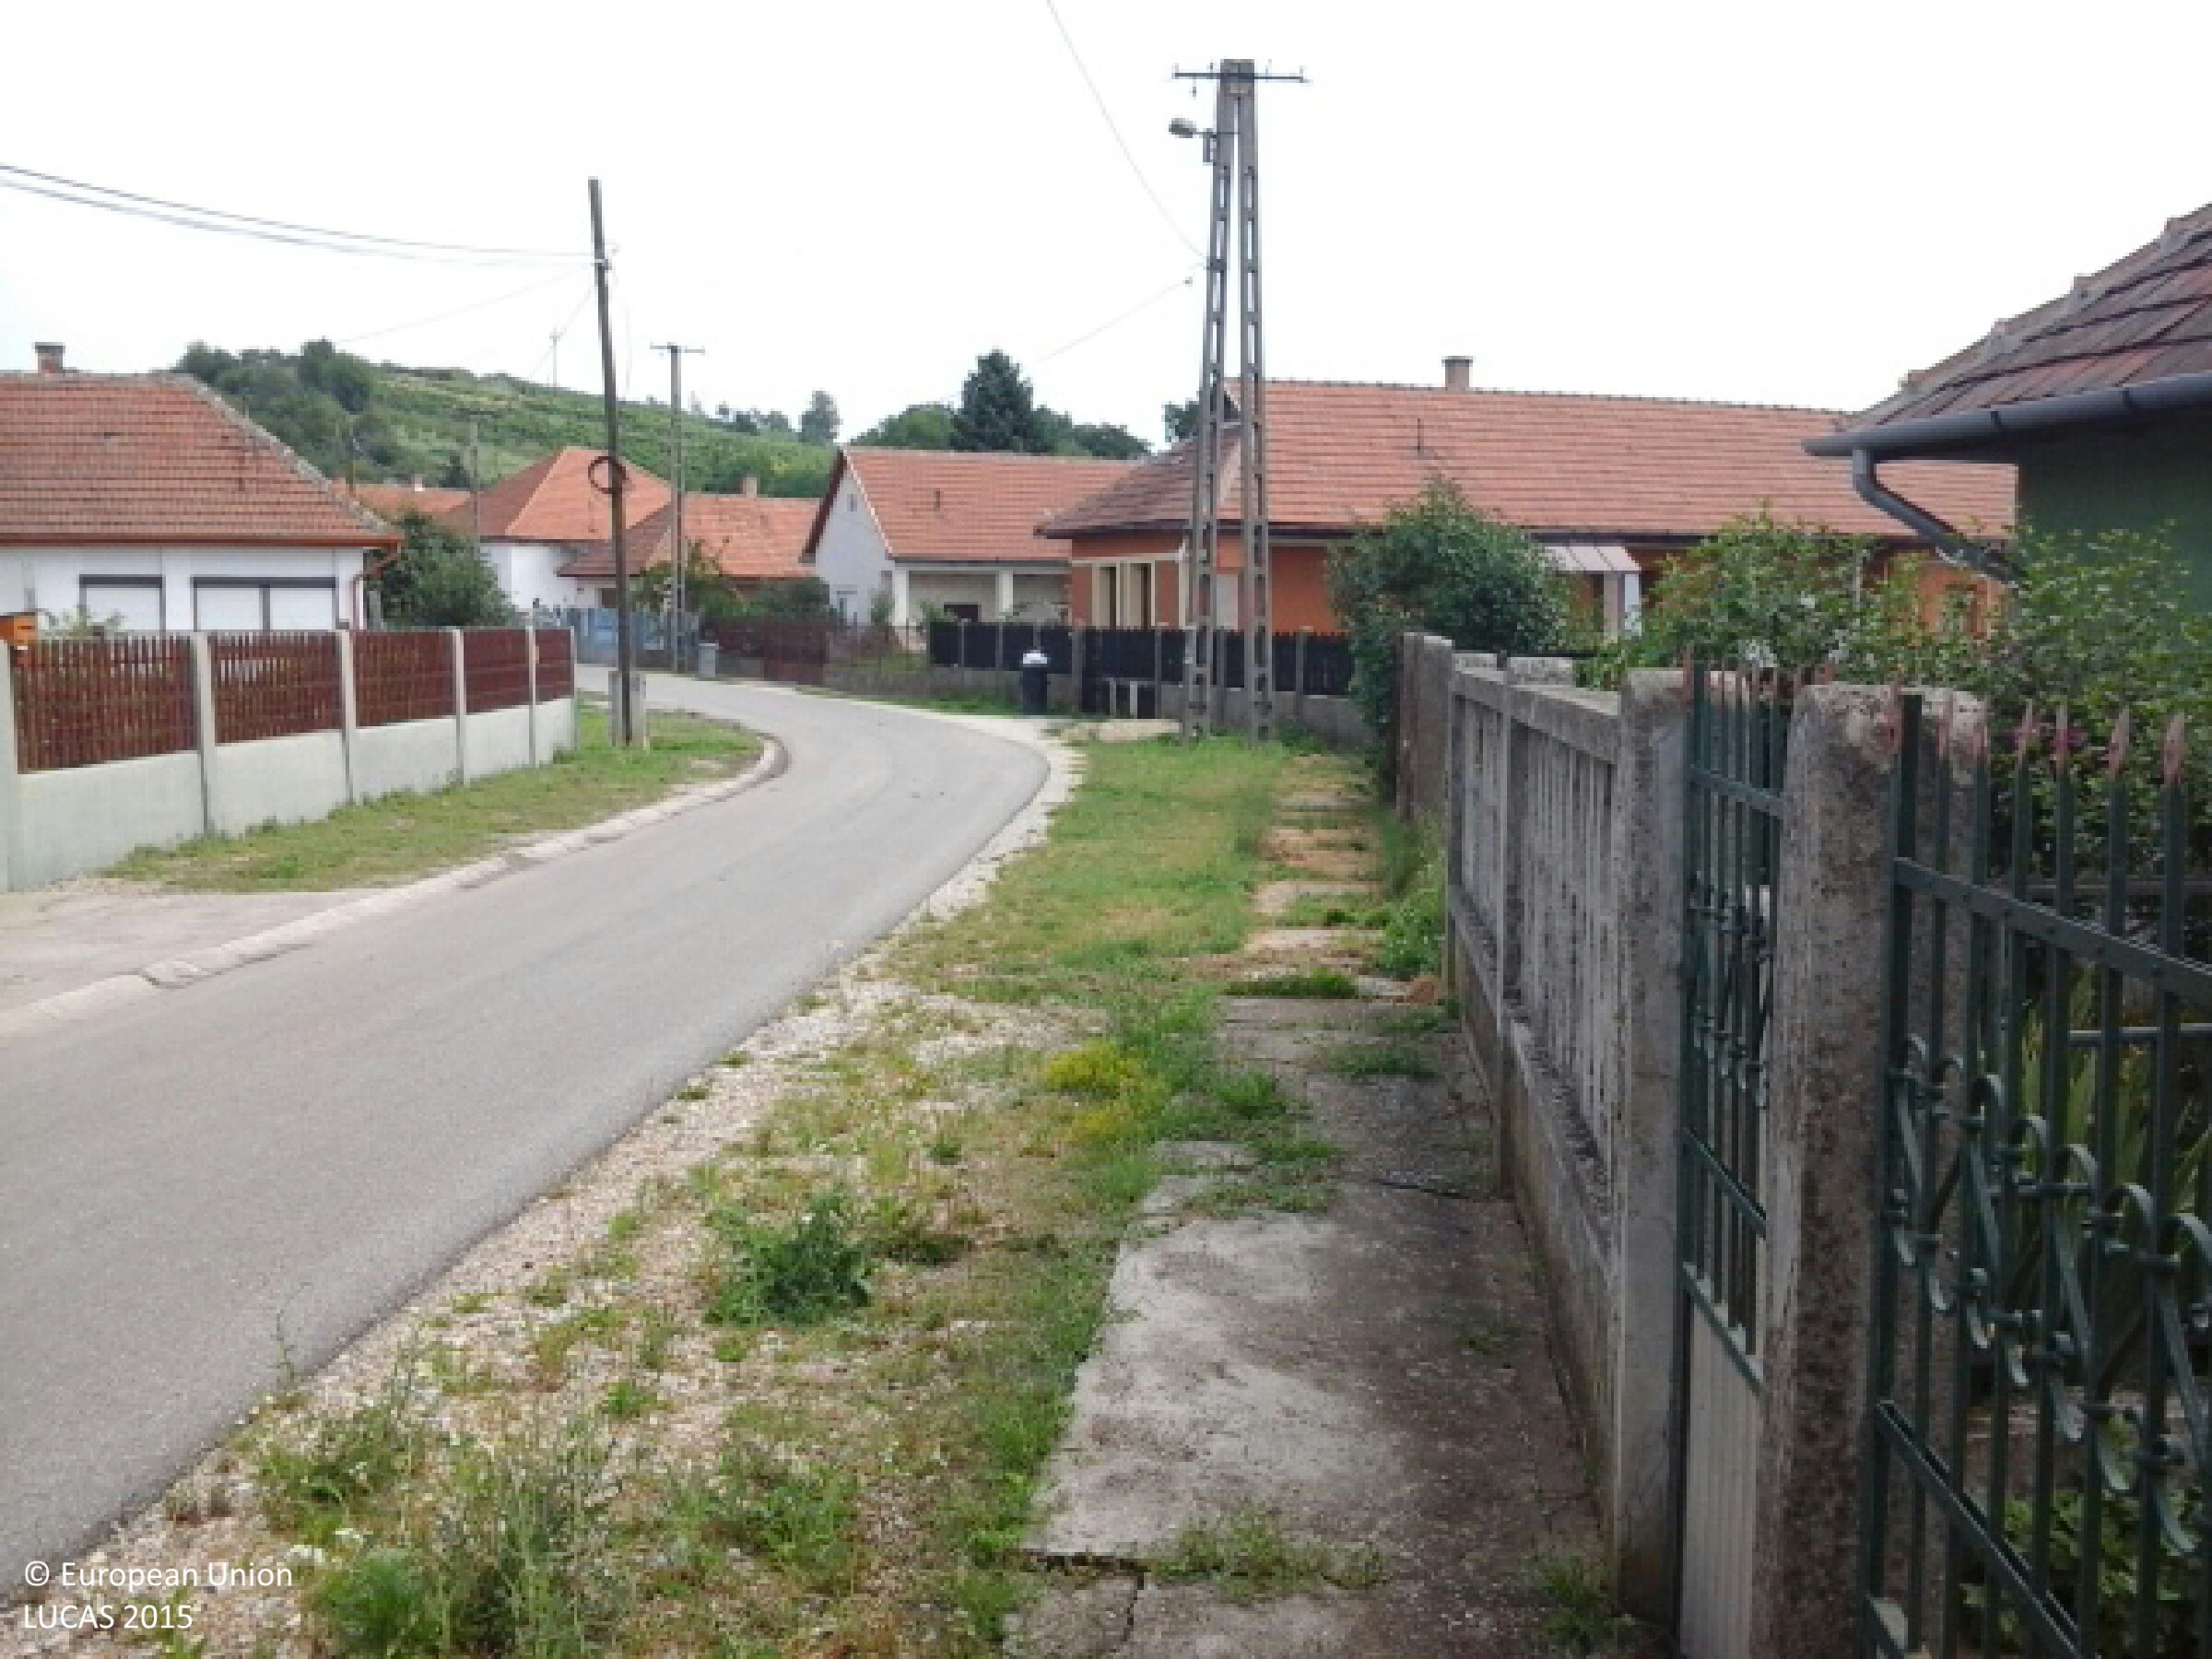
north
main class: Grassland
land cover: Grassland without tree/shrub cover
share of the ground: > 75 %
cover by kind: herbaceous plants 100 %
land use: Residential
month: July
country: HU
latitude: 48.2054
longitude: 20.9246
